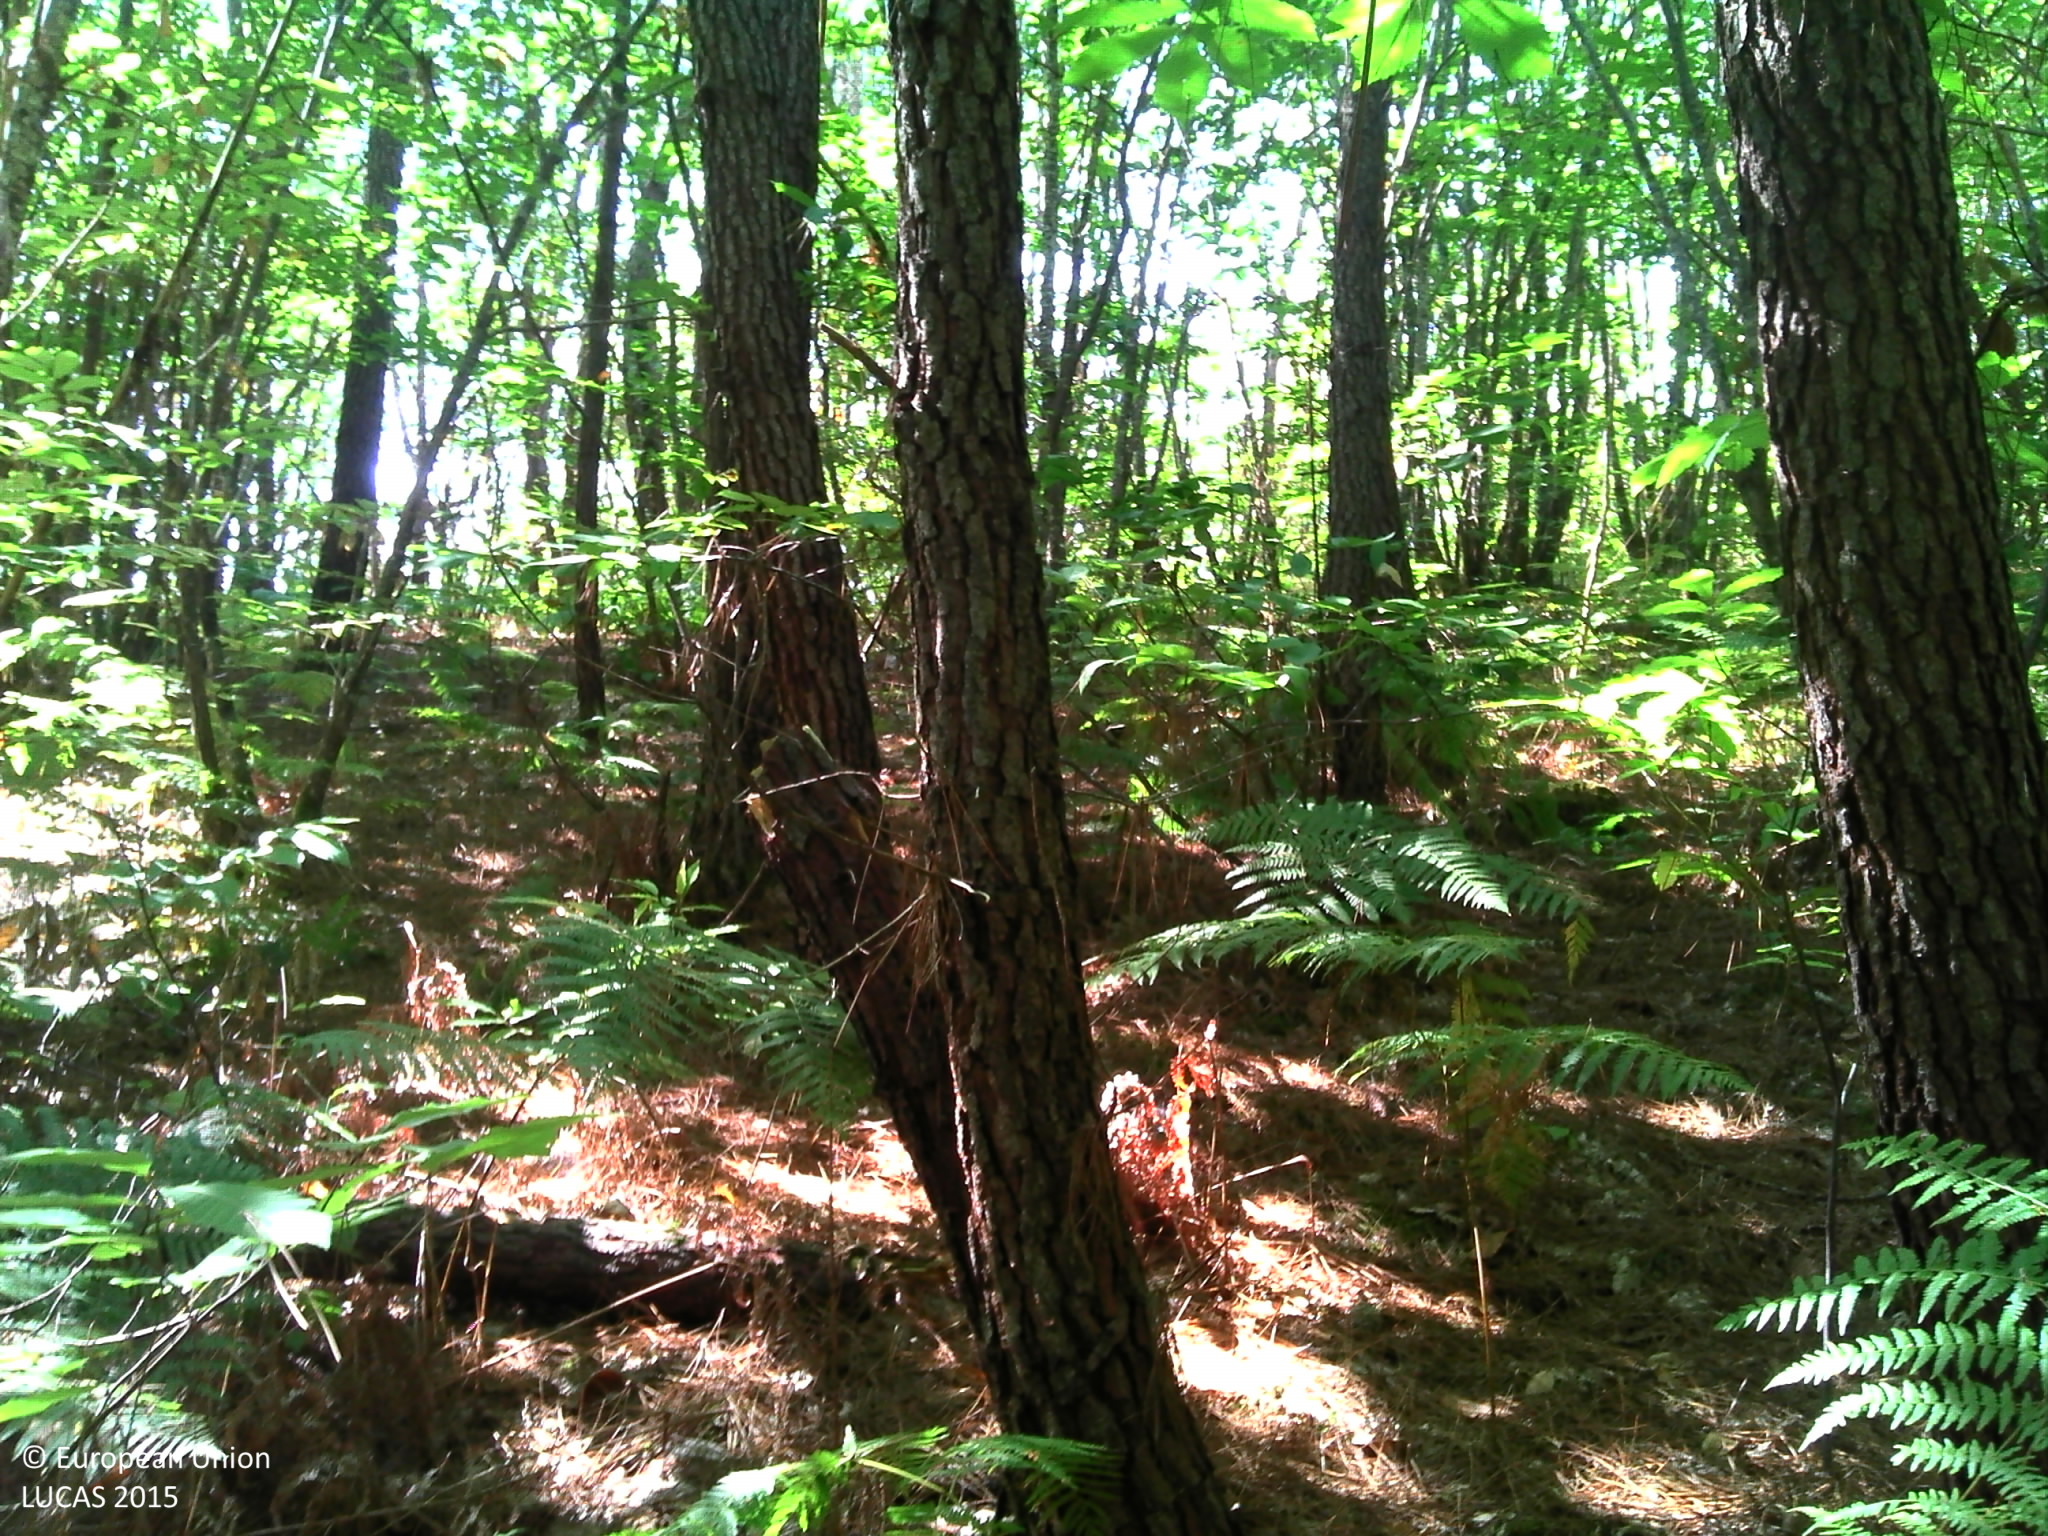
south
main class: Woodland
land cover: Pine dominated mixed woodland
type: thermophilous deciduous forest
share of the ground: > 75 %
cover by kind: broadleaved forest trees 40 %, coniferous forest trees 30 %, herbaceous plants 20 %, shrubs 5 %, consolidated bare surface 5 %
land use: Forestry
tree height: > 5 m
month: August
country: FR
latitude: 45.1420
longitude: 0.4376
